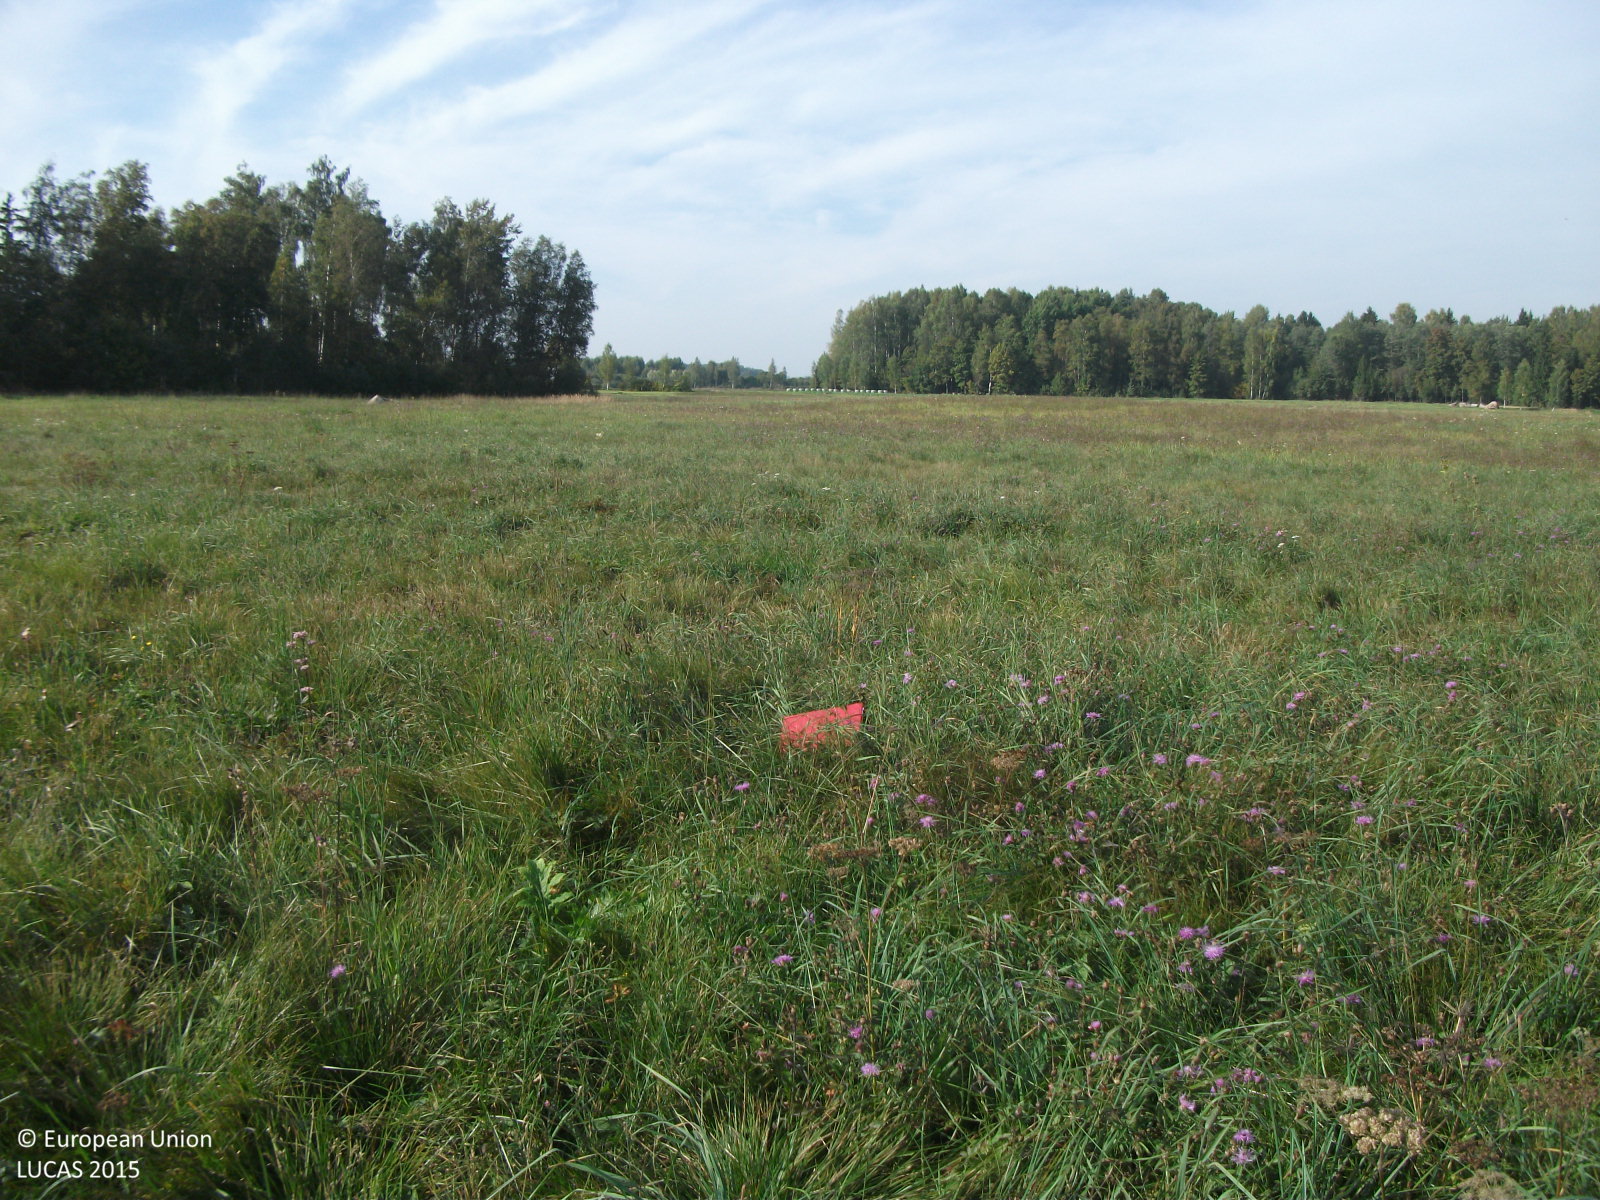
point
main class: Grassland
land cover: Grassland without tree/shrub cover
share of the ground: > 75 %
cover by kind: herbaceous plants 100 %
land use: Agriculture (excluding fallow land and kitchen gardens)
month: September
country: LV
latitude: 57.7663
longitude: 24.9084
